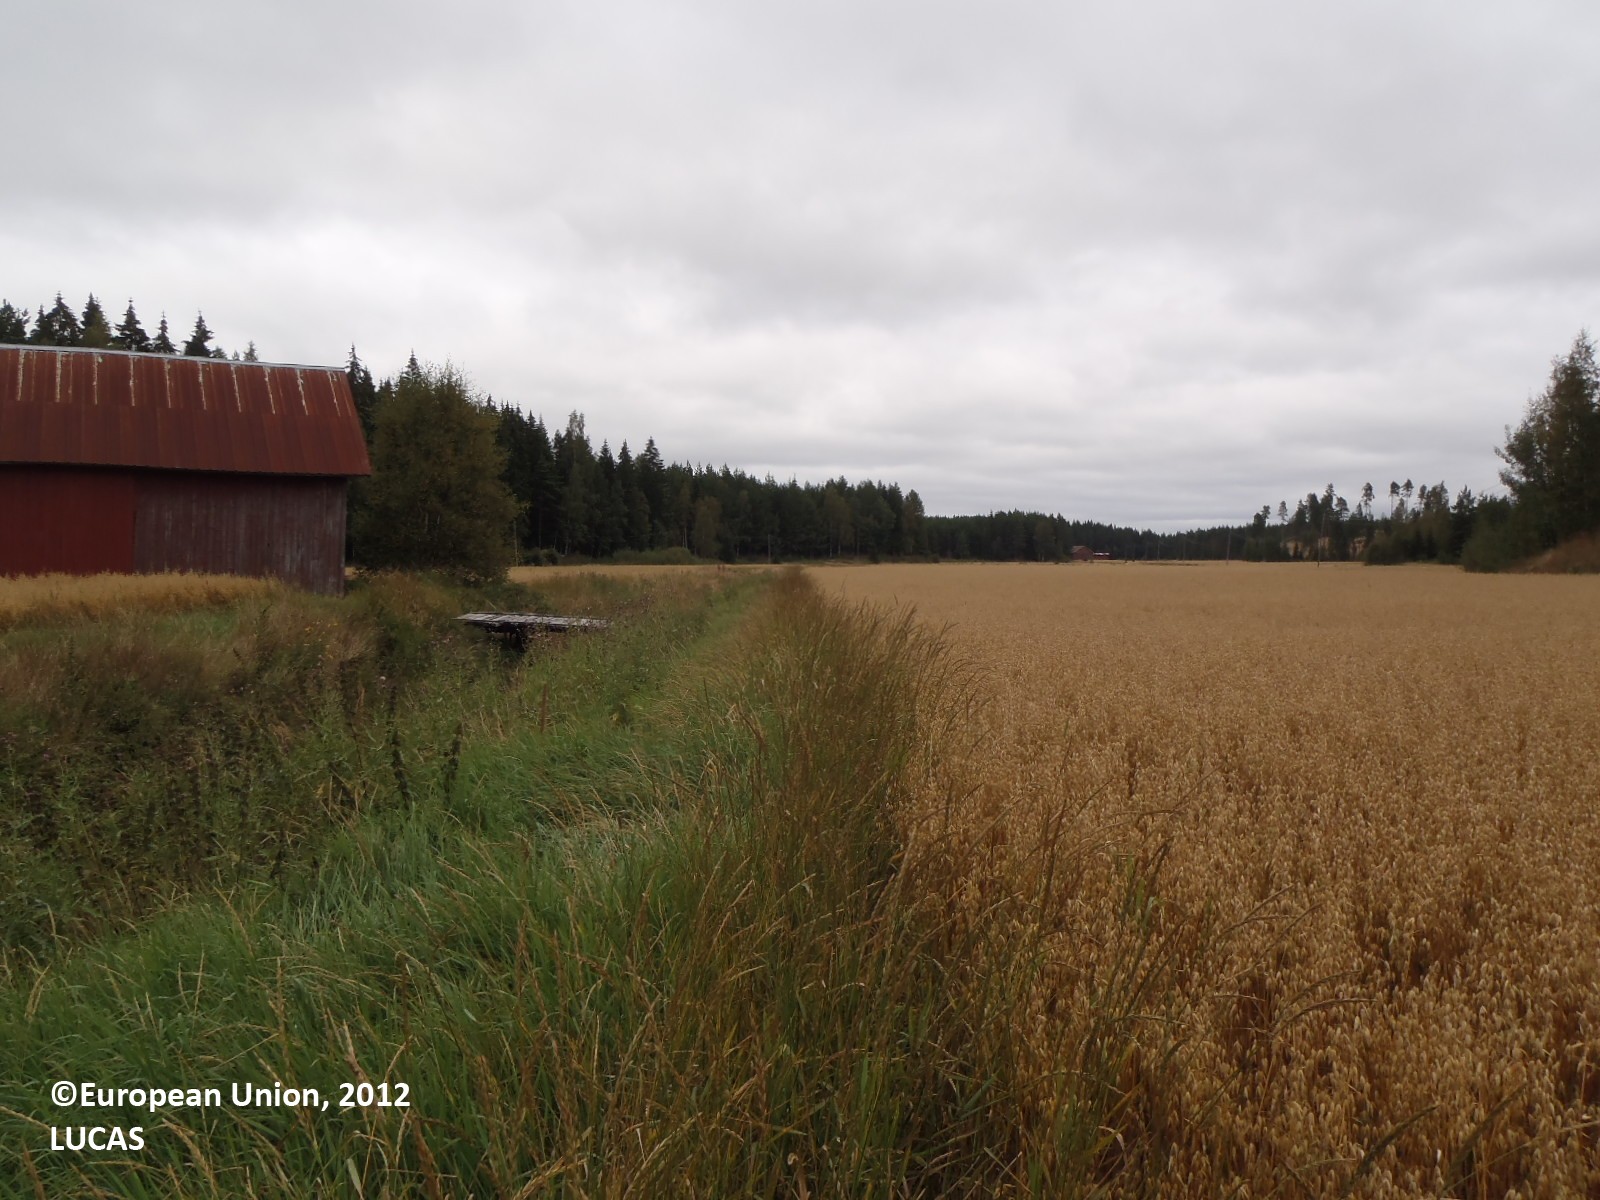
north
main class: Cropland
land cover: Oats
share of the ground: > 75 %
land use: Agriculture (excluding fallow land and kitchen gardens)
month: August
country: FI
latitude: 60.7631
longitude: 21.9731
